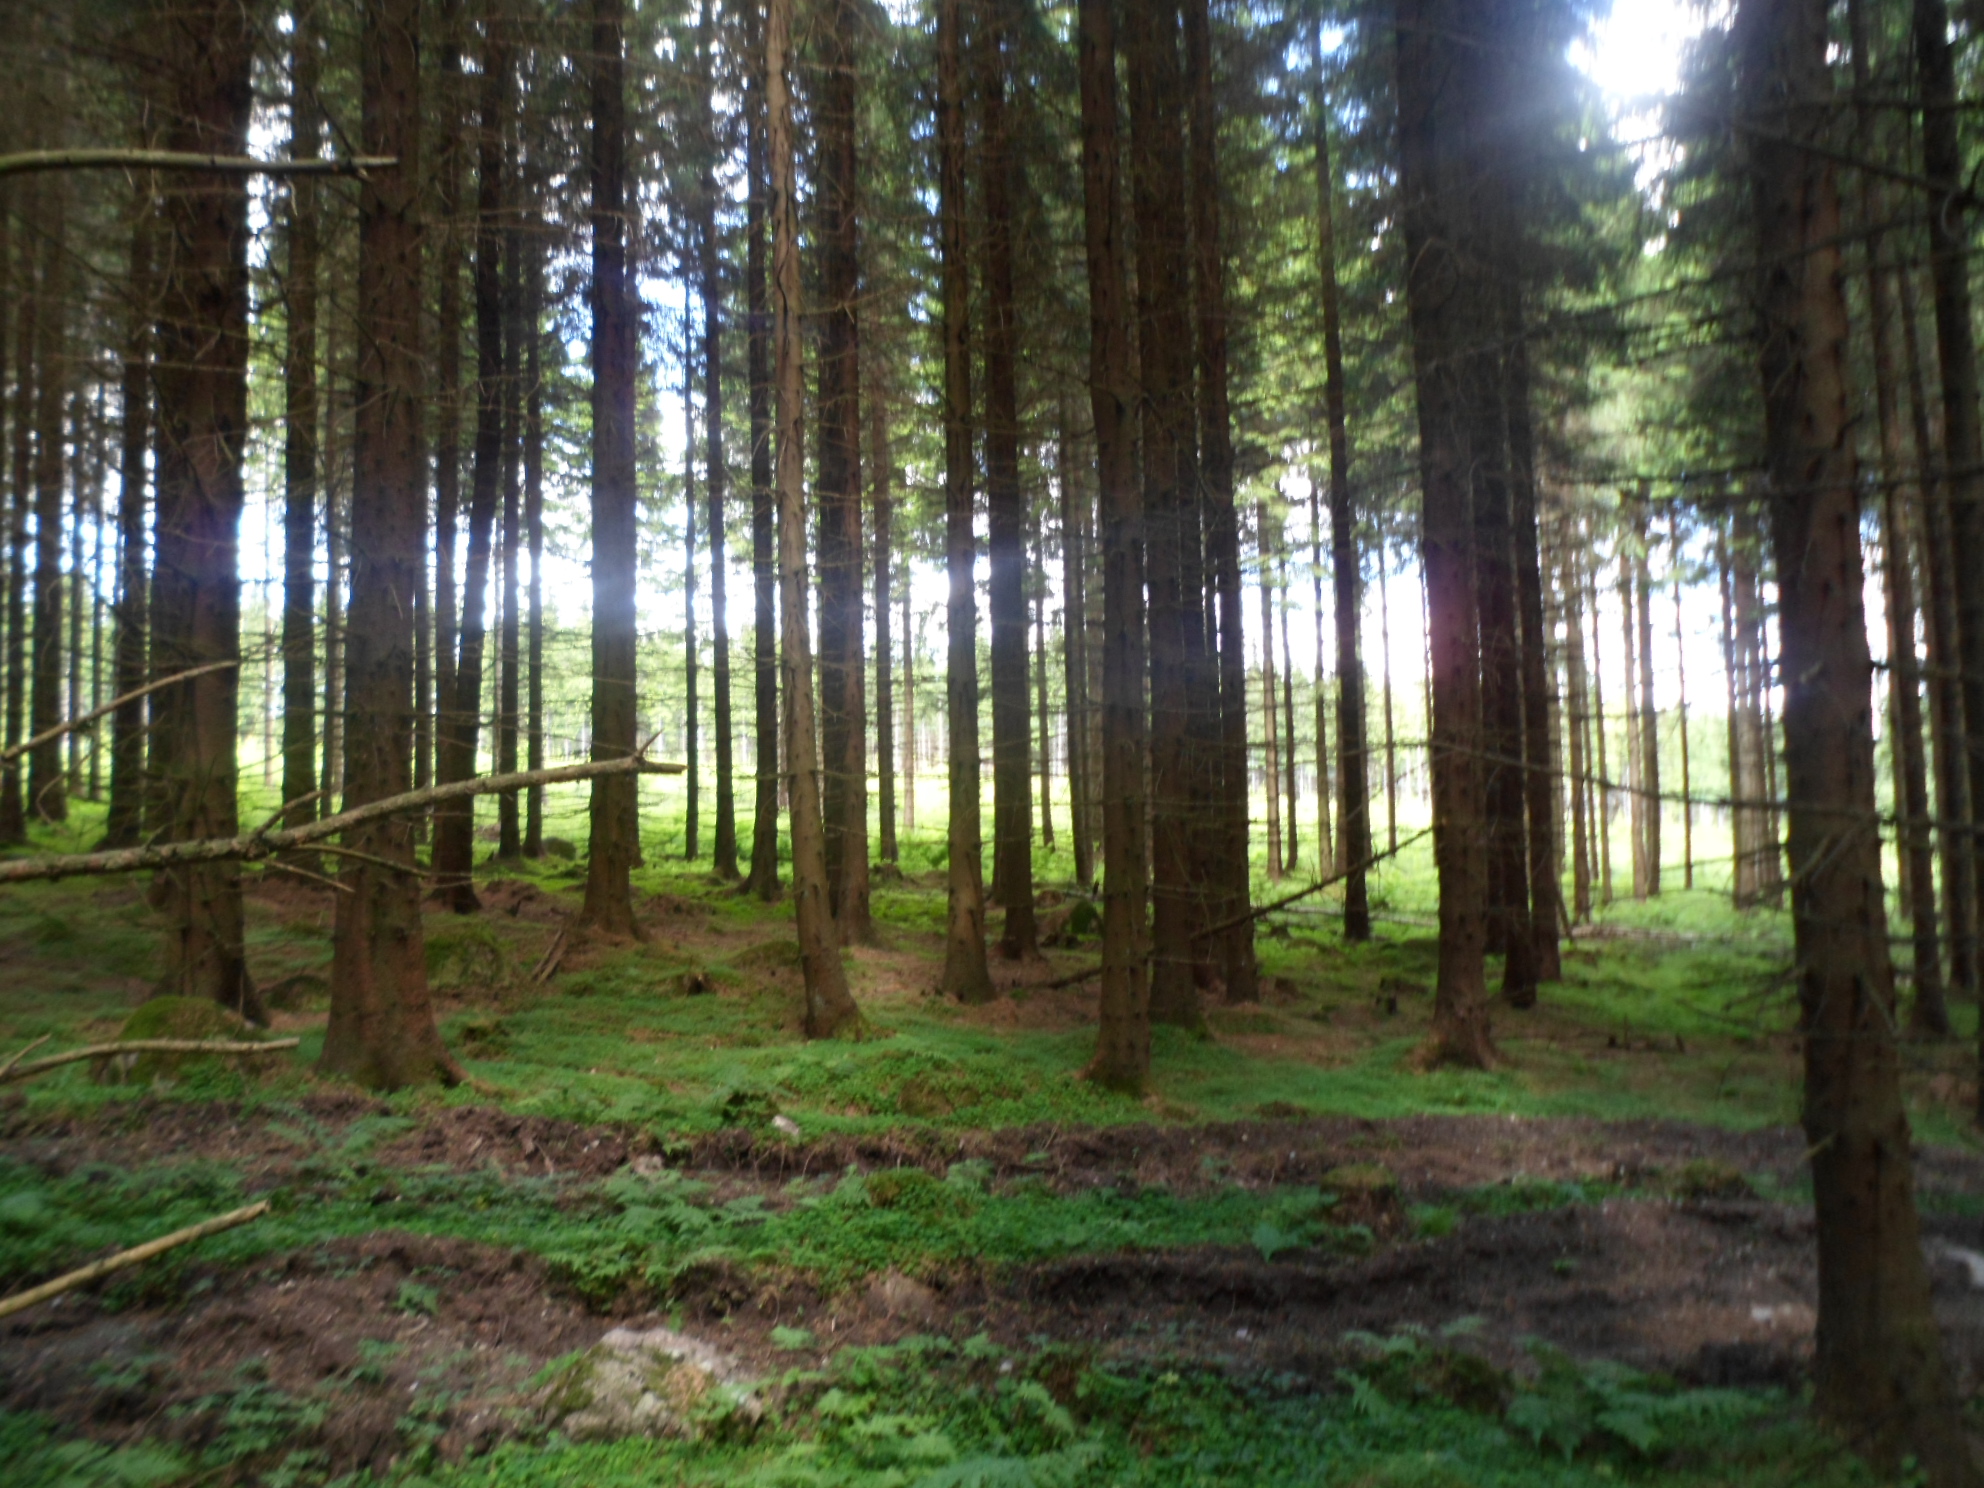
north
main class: Woodland
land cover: Spruce dominated coniferous woodland
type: boreal forest
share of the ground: > 75 %
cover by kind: coniferous forest trees 80 %, herbaceous plants 10 %, lichens and mosses 5 %, unconsolidated bare surface 5 %
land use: Forestry
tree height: > 5 m
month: July
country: SE
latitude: 57.4413
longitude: 14.5108
